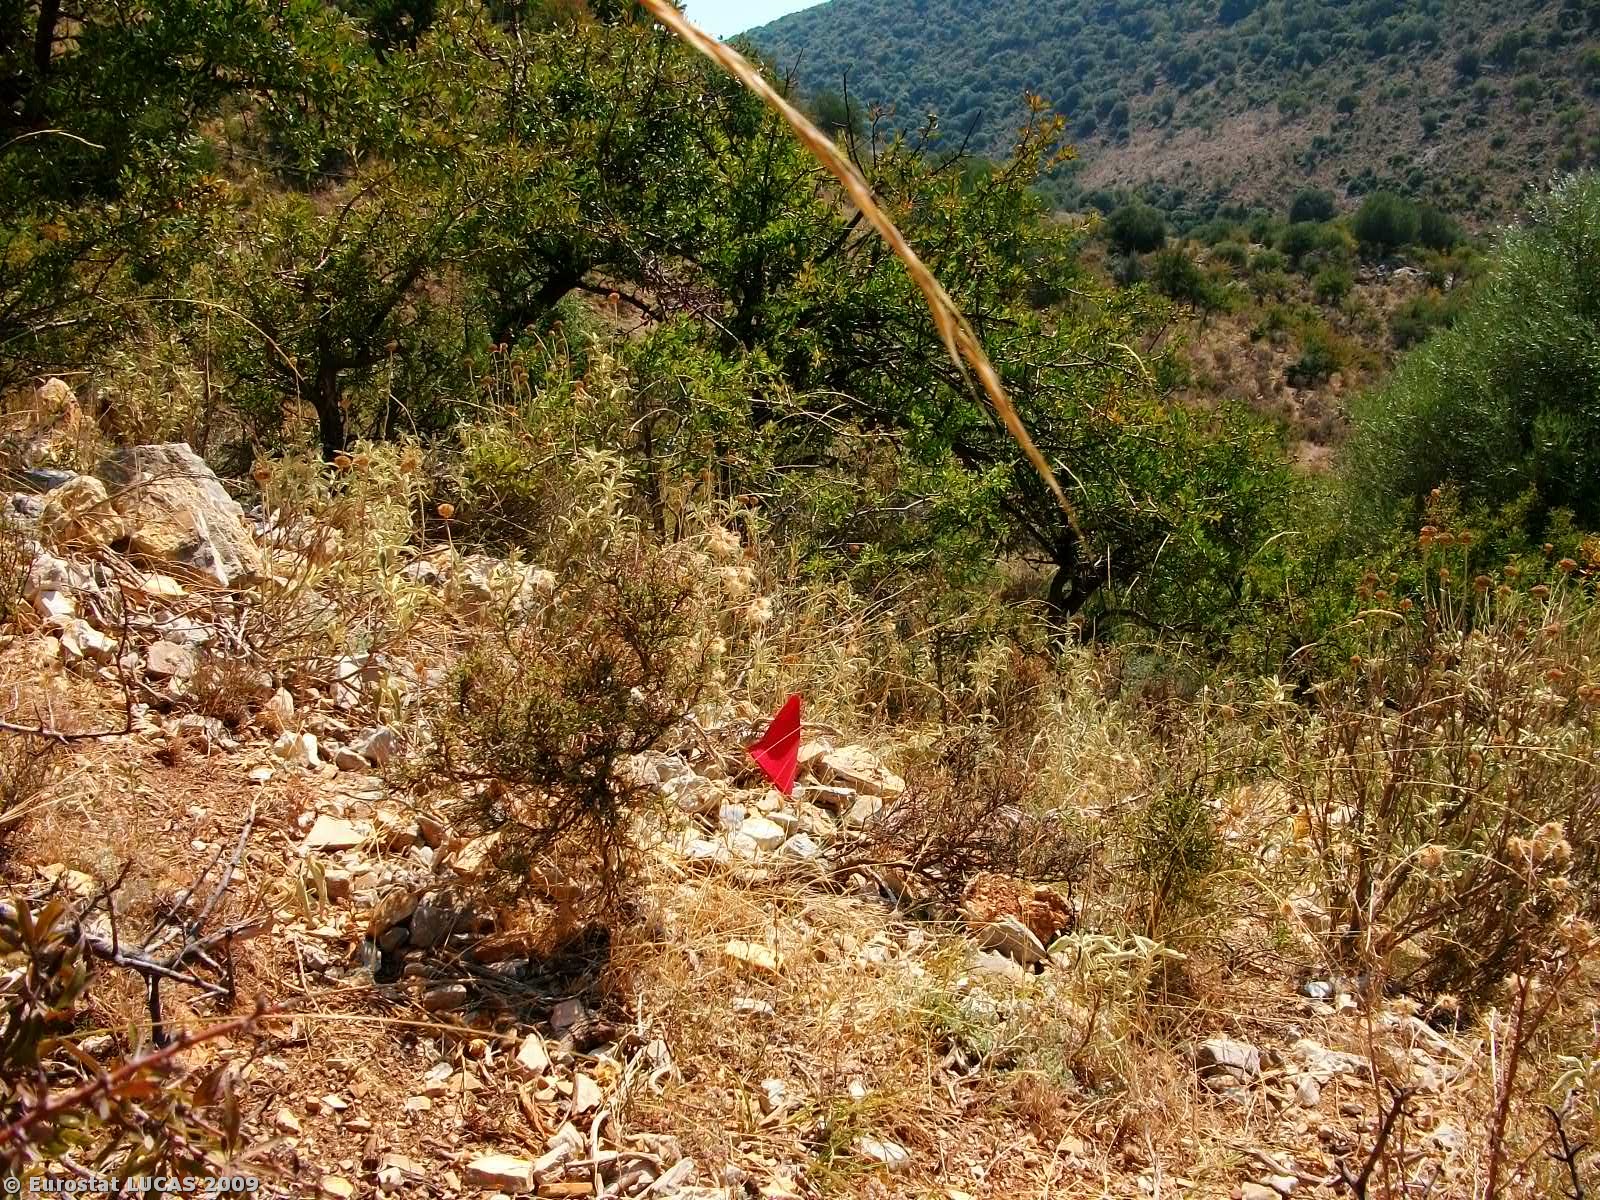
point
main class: Grassland
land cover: Grassland with sparse tree/shrub cover
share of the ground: 50 - 75 %
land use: Agriculture (excluding fallow land and kitchen gardens)
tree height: < 5 m
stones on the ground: 25 - 50 %
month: September
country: GR
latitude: 39.5061
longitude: 20.2898
